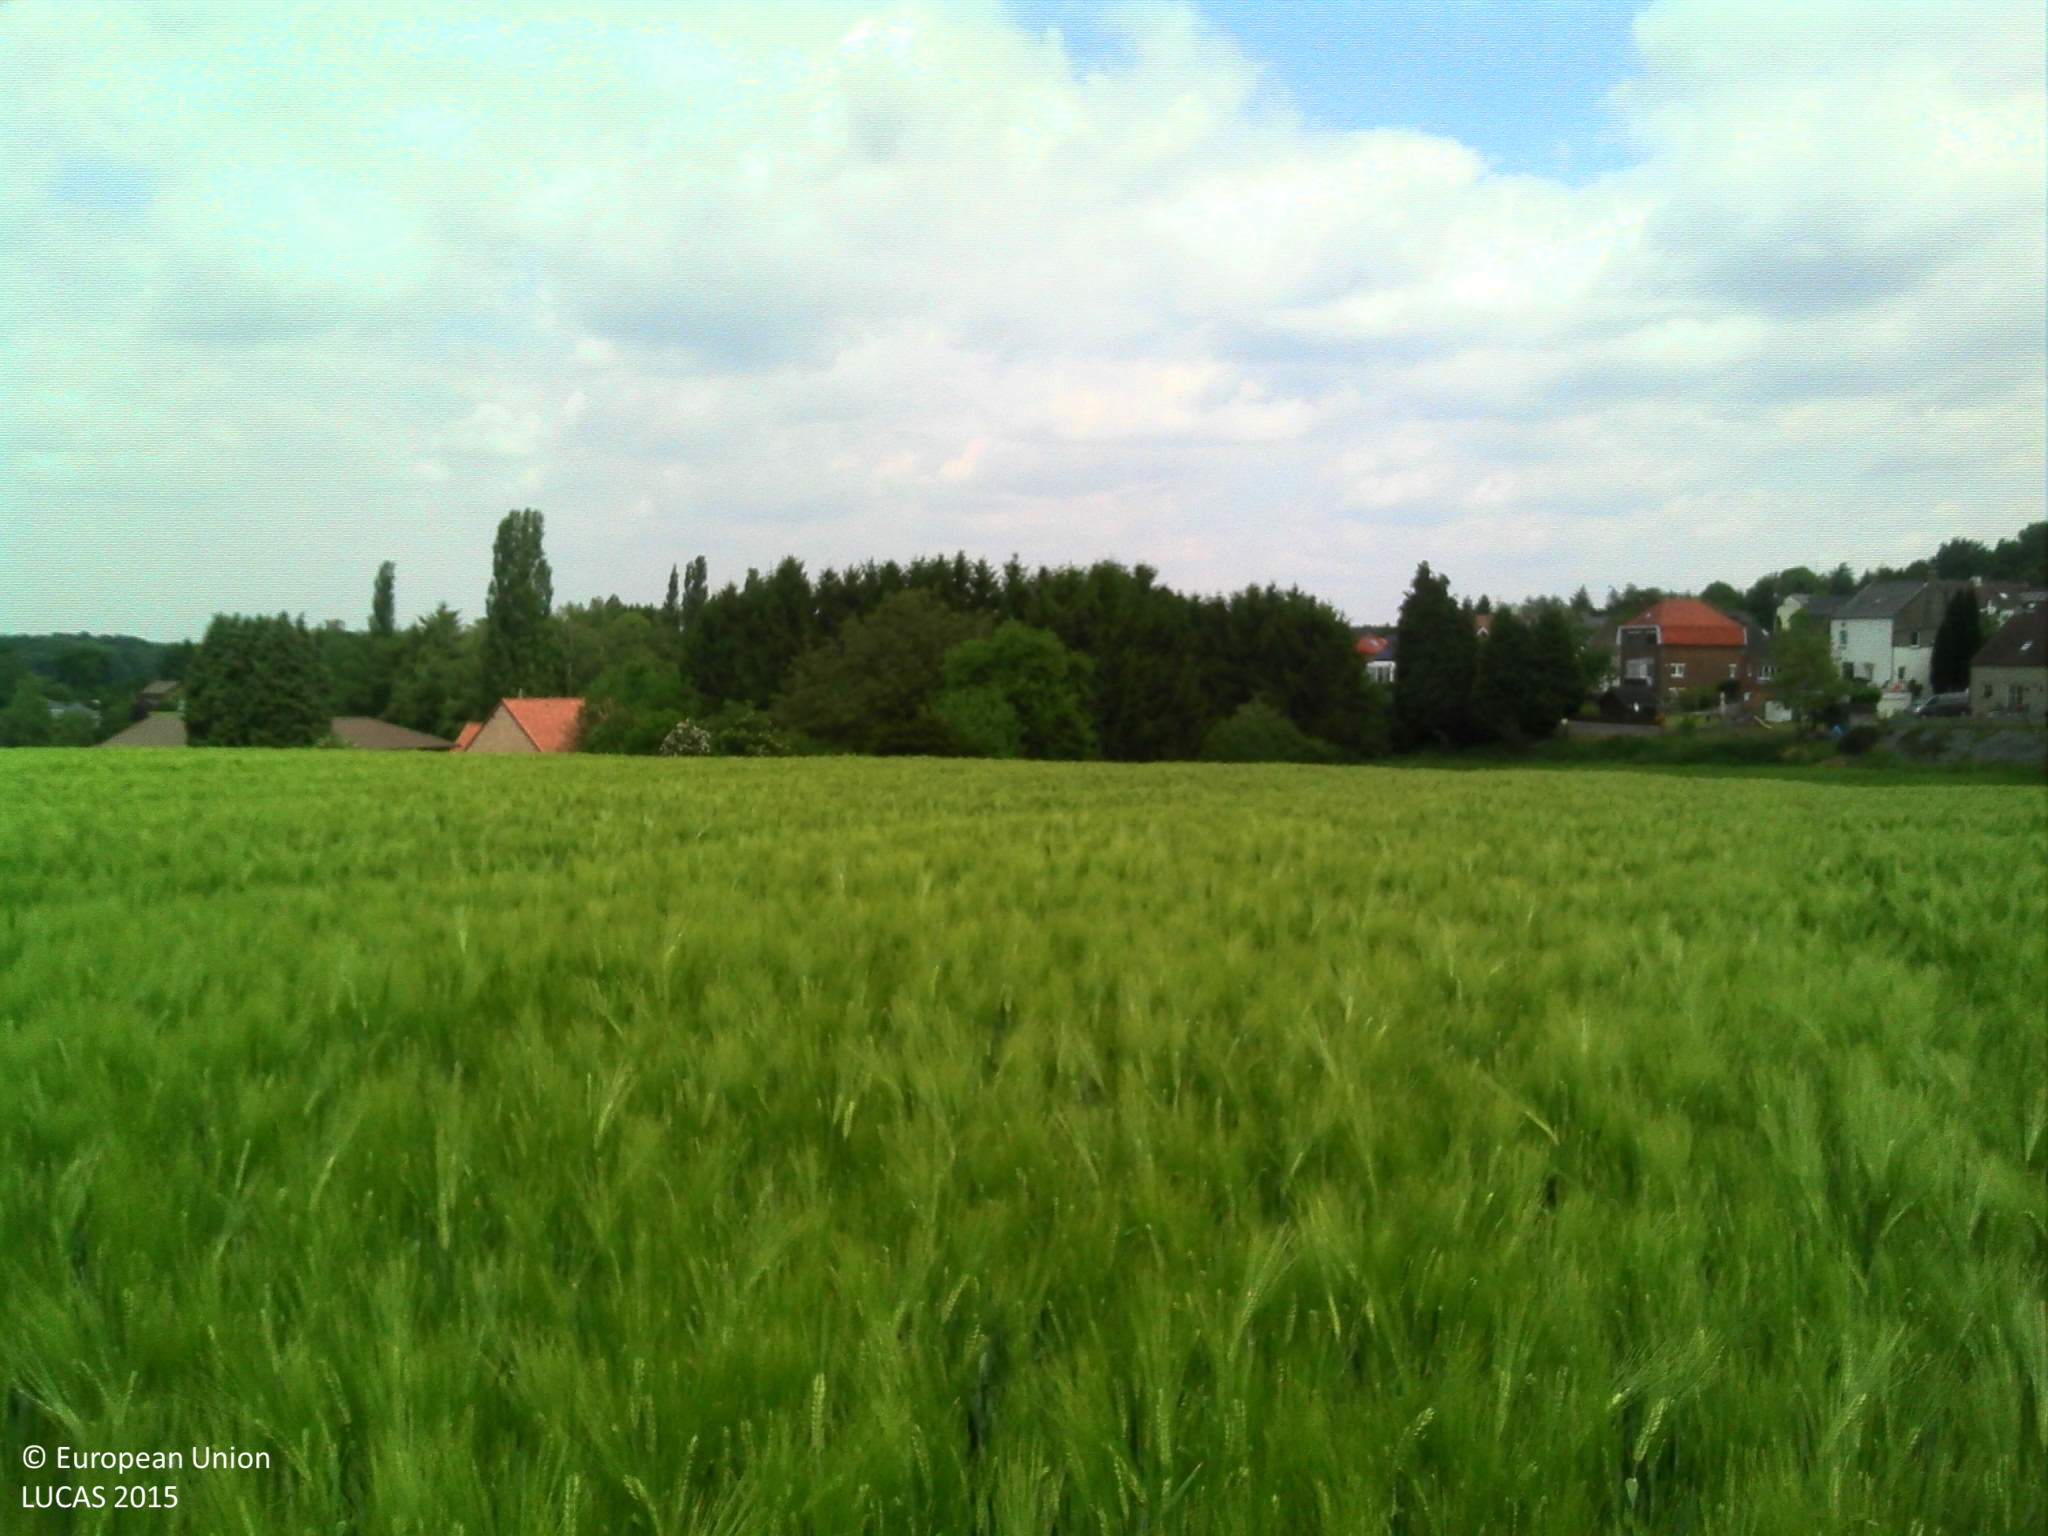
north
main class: Cropland
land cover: Barley
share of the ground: > 75 %
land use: Agriculture (excluding fallow land and kitchen gardens)
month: May
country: BE
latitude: 50.6129
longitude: 4.5551
